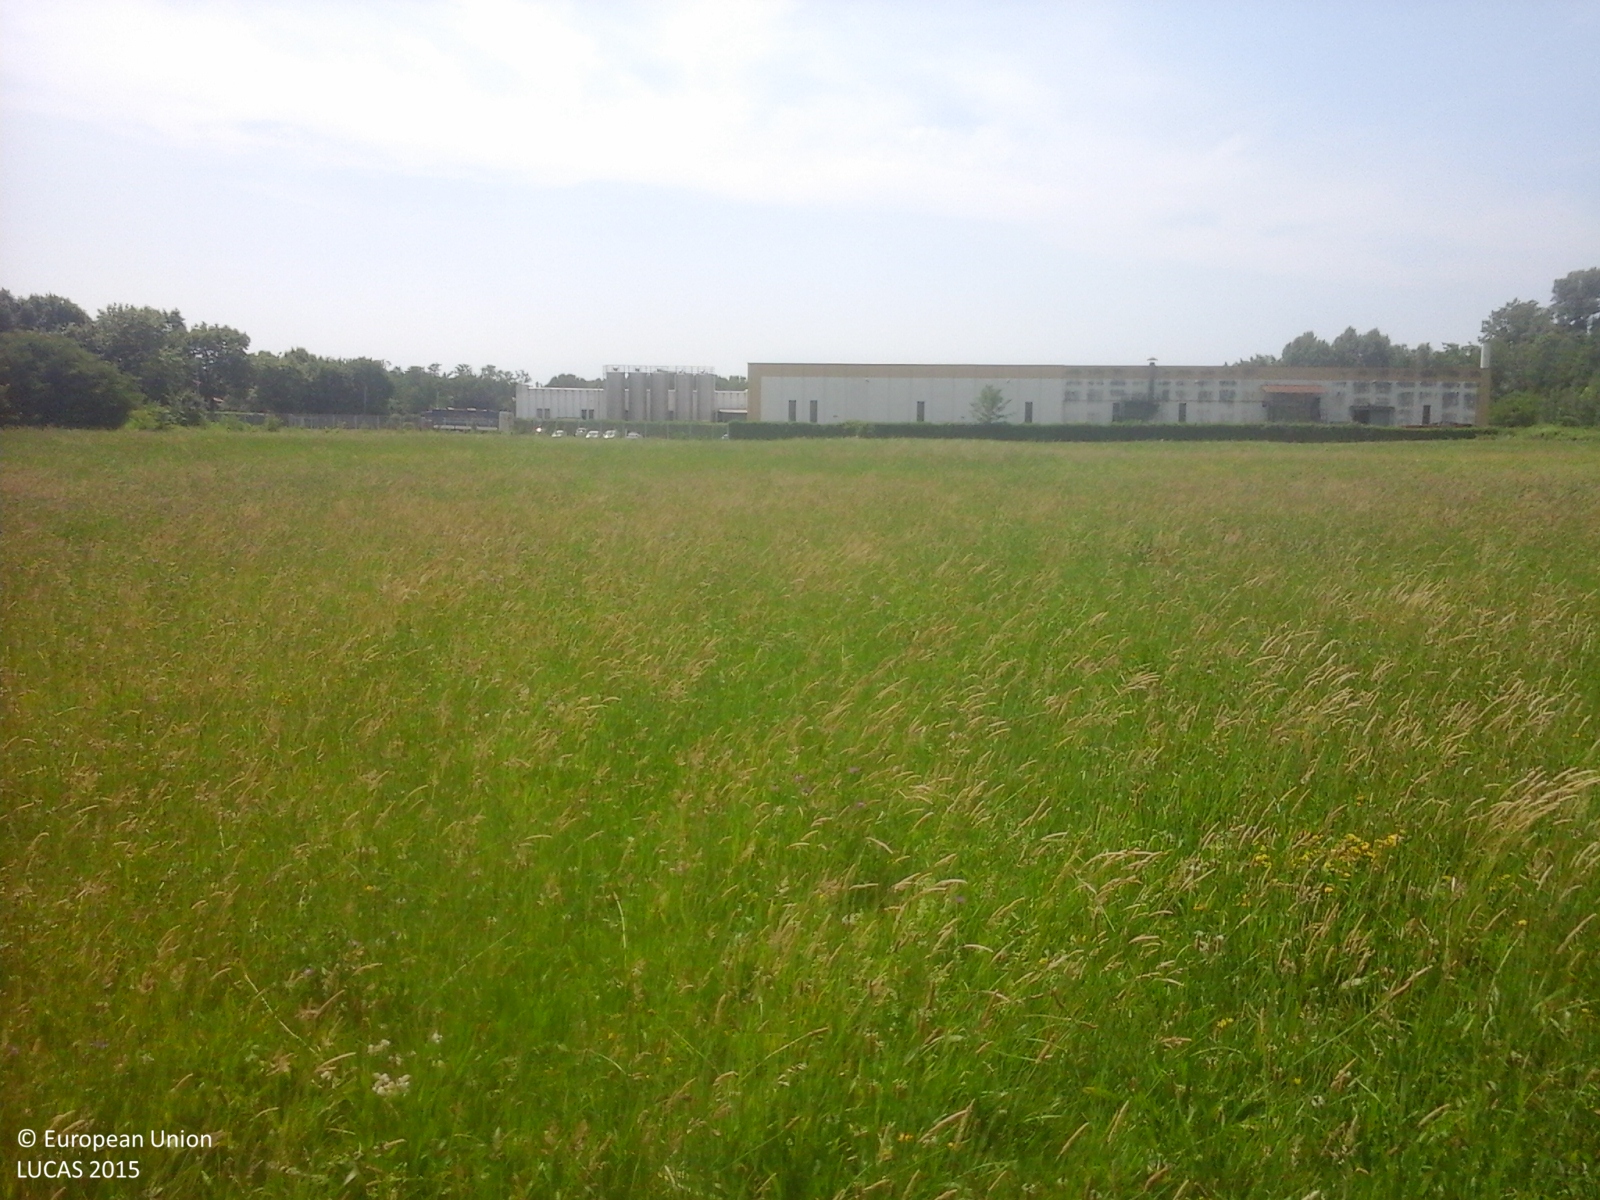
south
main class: Grassland
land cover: Grassland without tree/shrub cover
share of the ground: > 75 %
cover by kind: herbaceous plants 100 %
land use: Logistics and storage
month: June
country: IT
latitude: 45.6467
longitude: 9.3723
